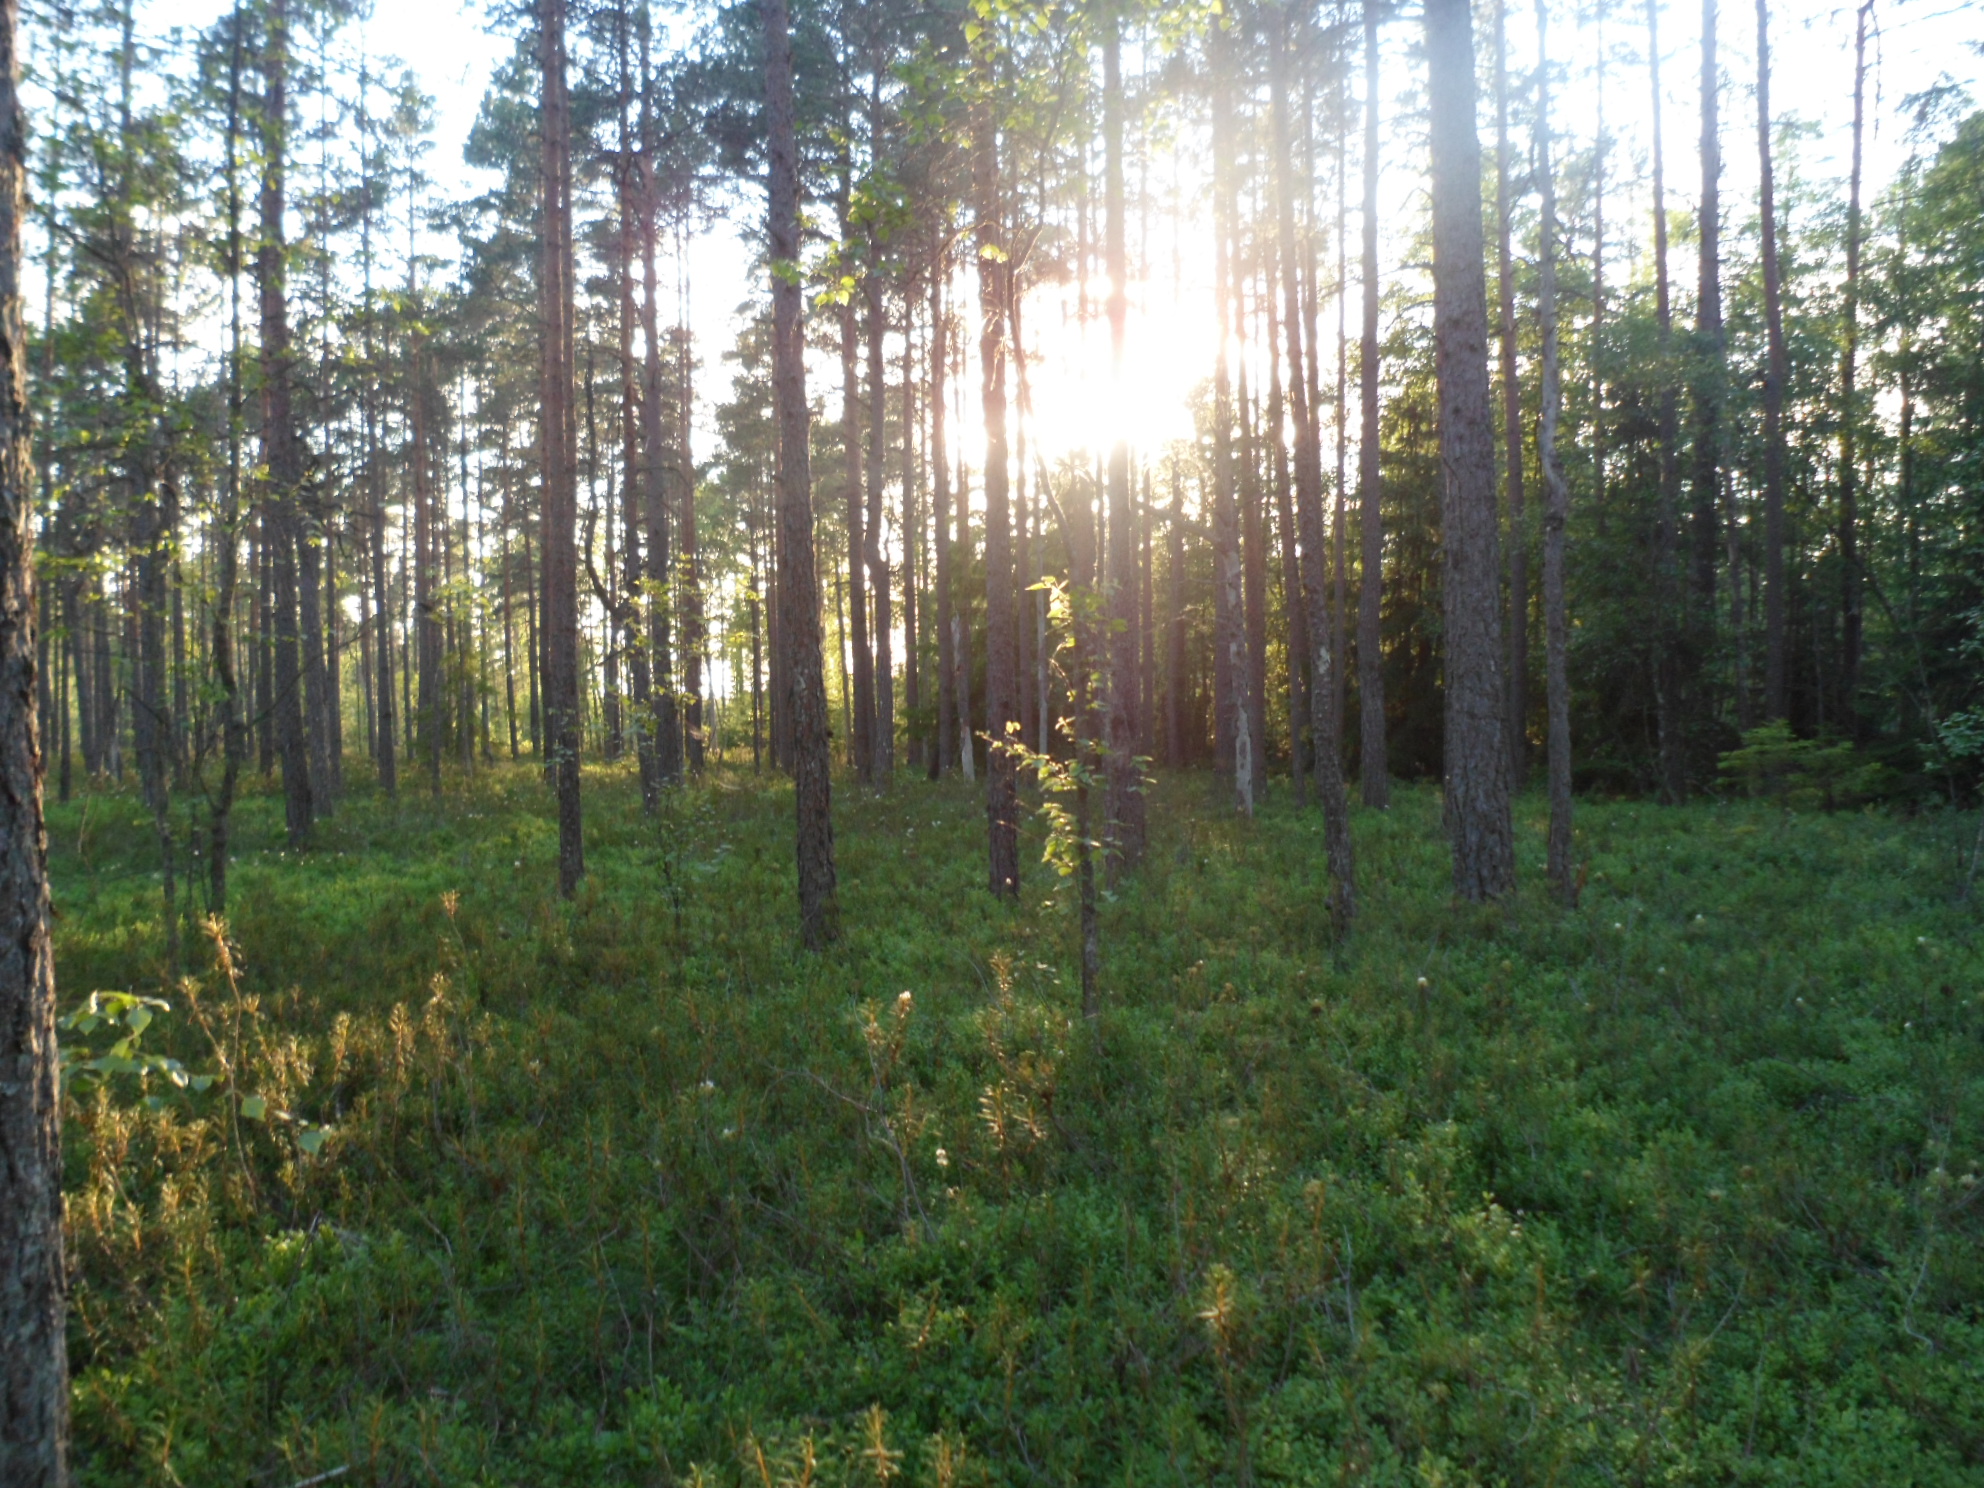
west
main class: Woodland
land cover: Pine dominated coniferous woodland
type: boreal forest
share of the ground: 50 - 75 %
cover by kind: coniferous forest trees 50 %, shrubs 35 %, broadleaved forest trees 5 %, herbaceous plants 5 %, lichens and mosses 5 %
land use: Forestry
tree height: > 5 m
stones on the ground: < 10 %
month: July
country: SE
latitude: 57.1935
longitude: 14.3816
